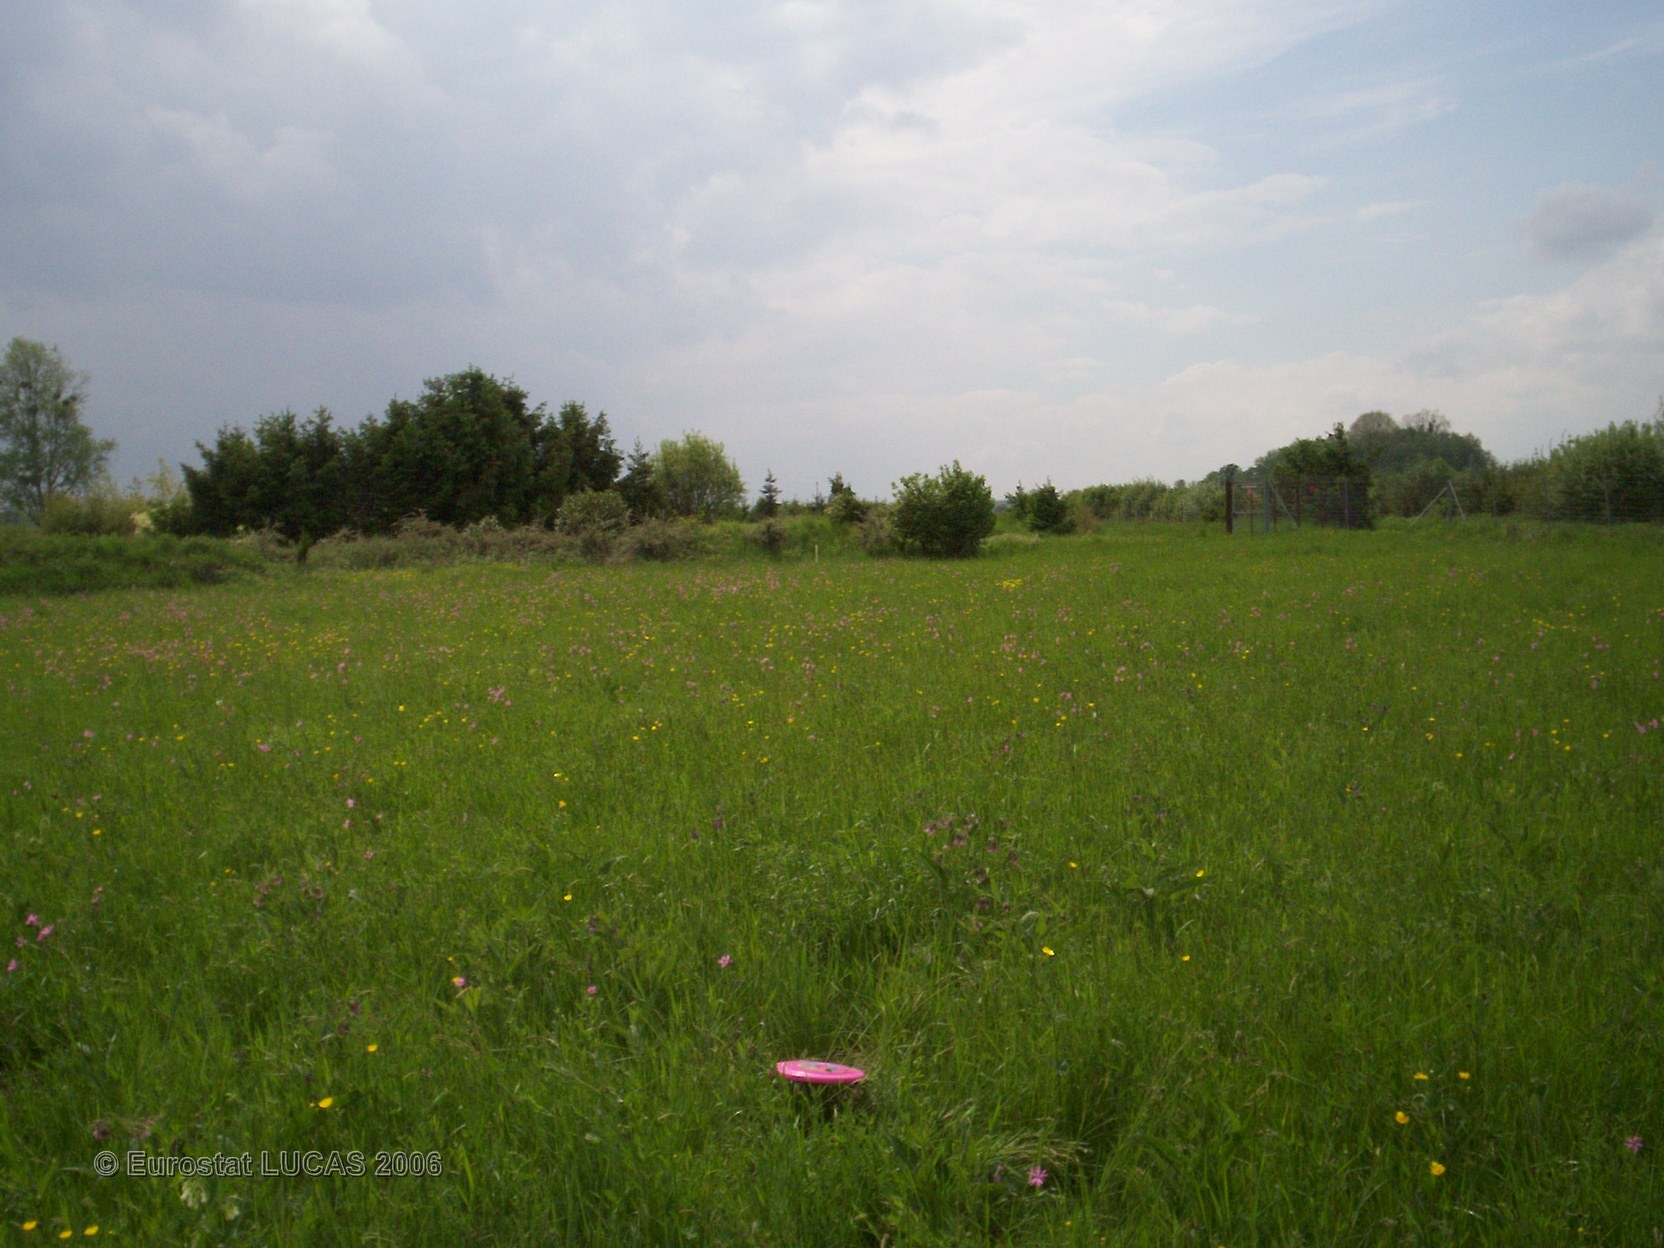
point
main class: Grassland
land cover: Grassland without tree/shrub cover
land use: Agriculture (excluding fallow land and kitchen gardens)
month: May
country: FR
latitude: 49.5791
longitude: 4.4224
